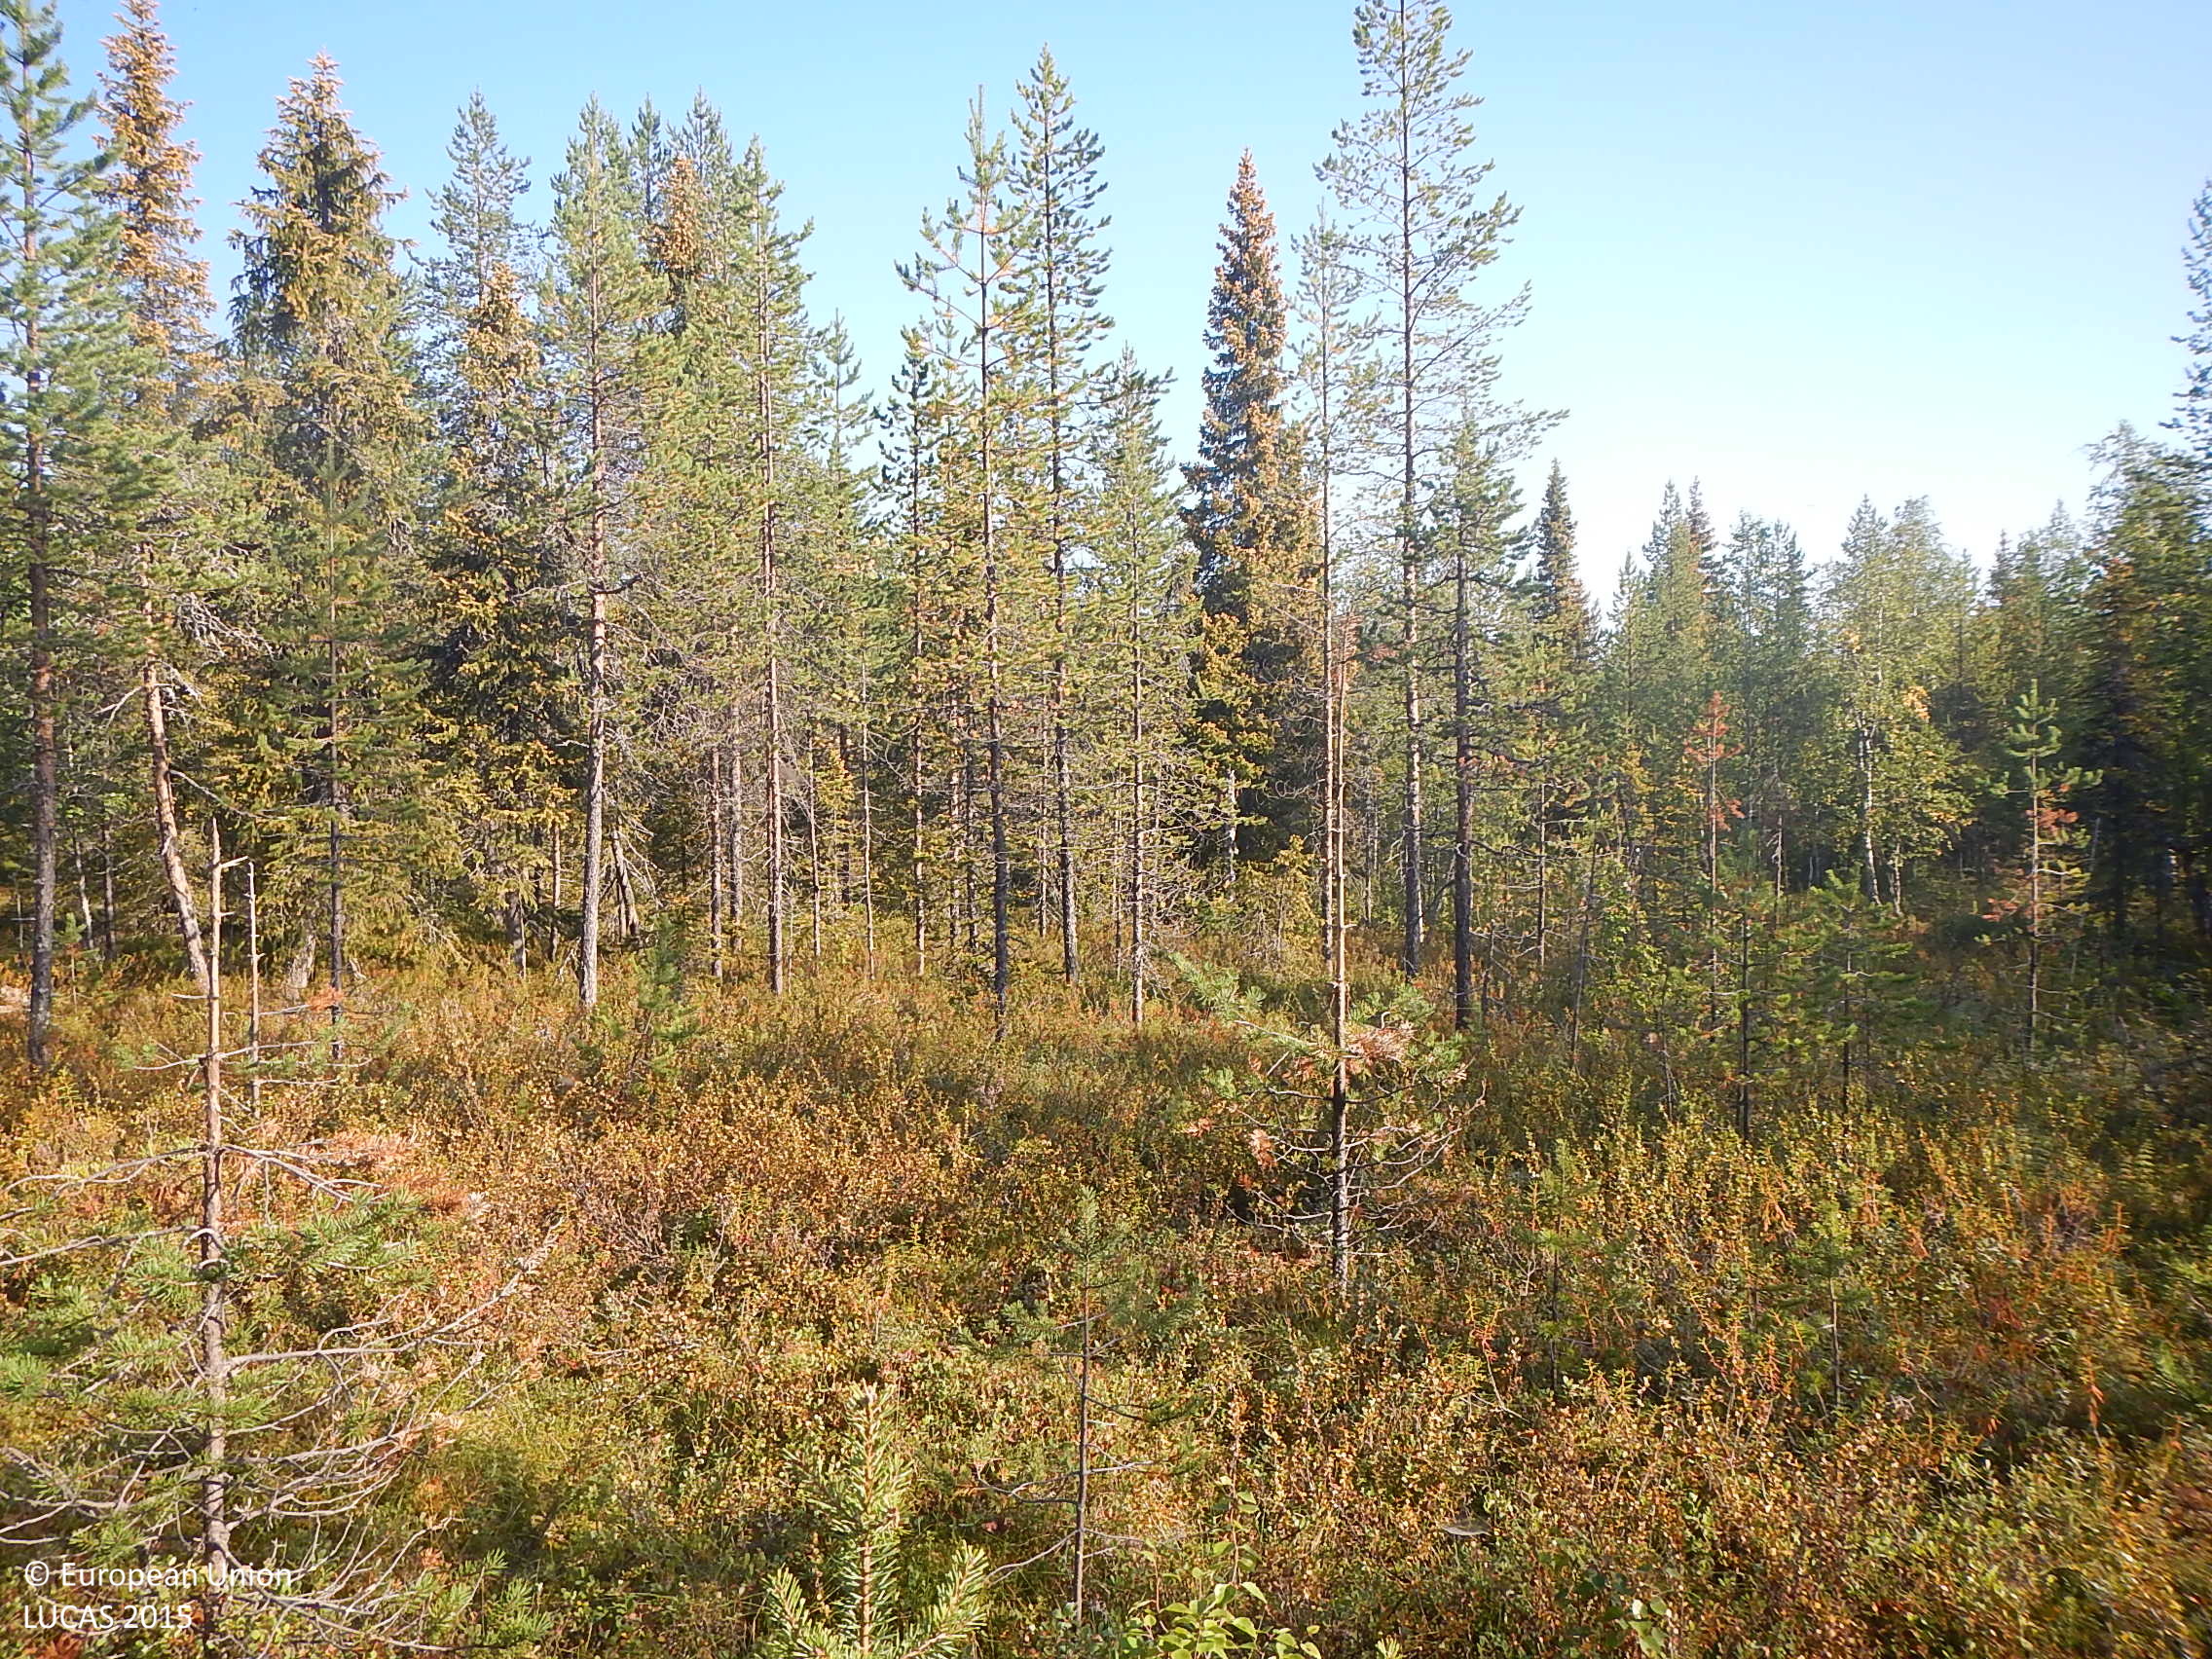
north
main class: Woodland
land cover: Pine dominated coniferous woodland
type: boreal forest
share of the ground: 10 - 25 %
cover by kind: shrubs 70 %, coniferous forest trees 15 %, lichens and mosses 10 %, herbaceous plants 5 %
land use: Forestry
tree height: < 5 m
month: August
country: FI
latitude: 66.4643
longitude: 28.2486
